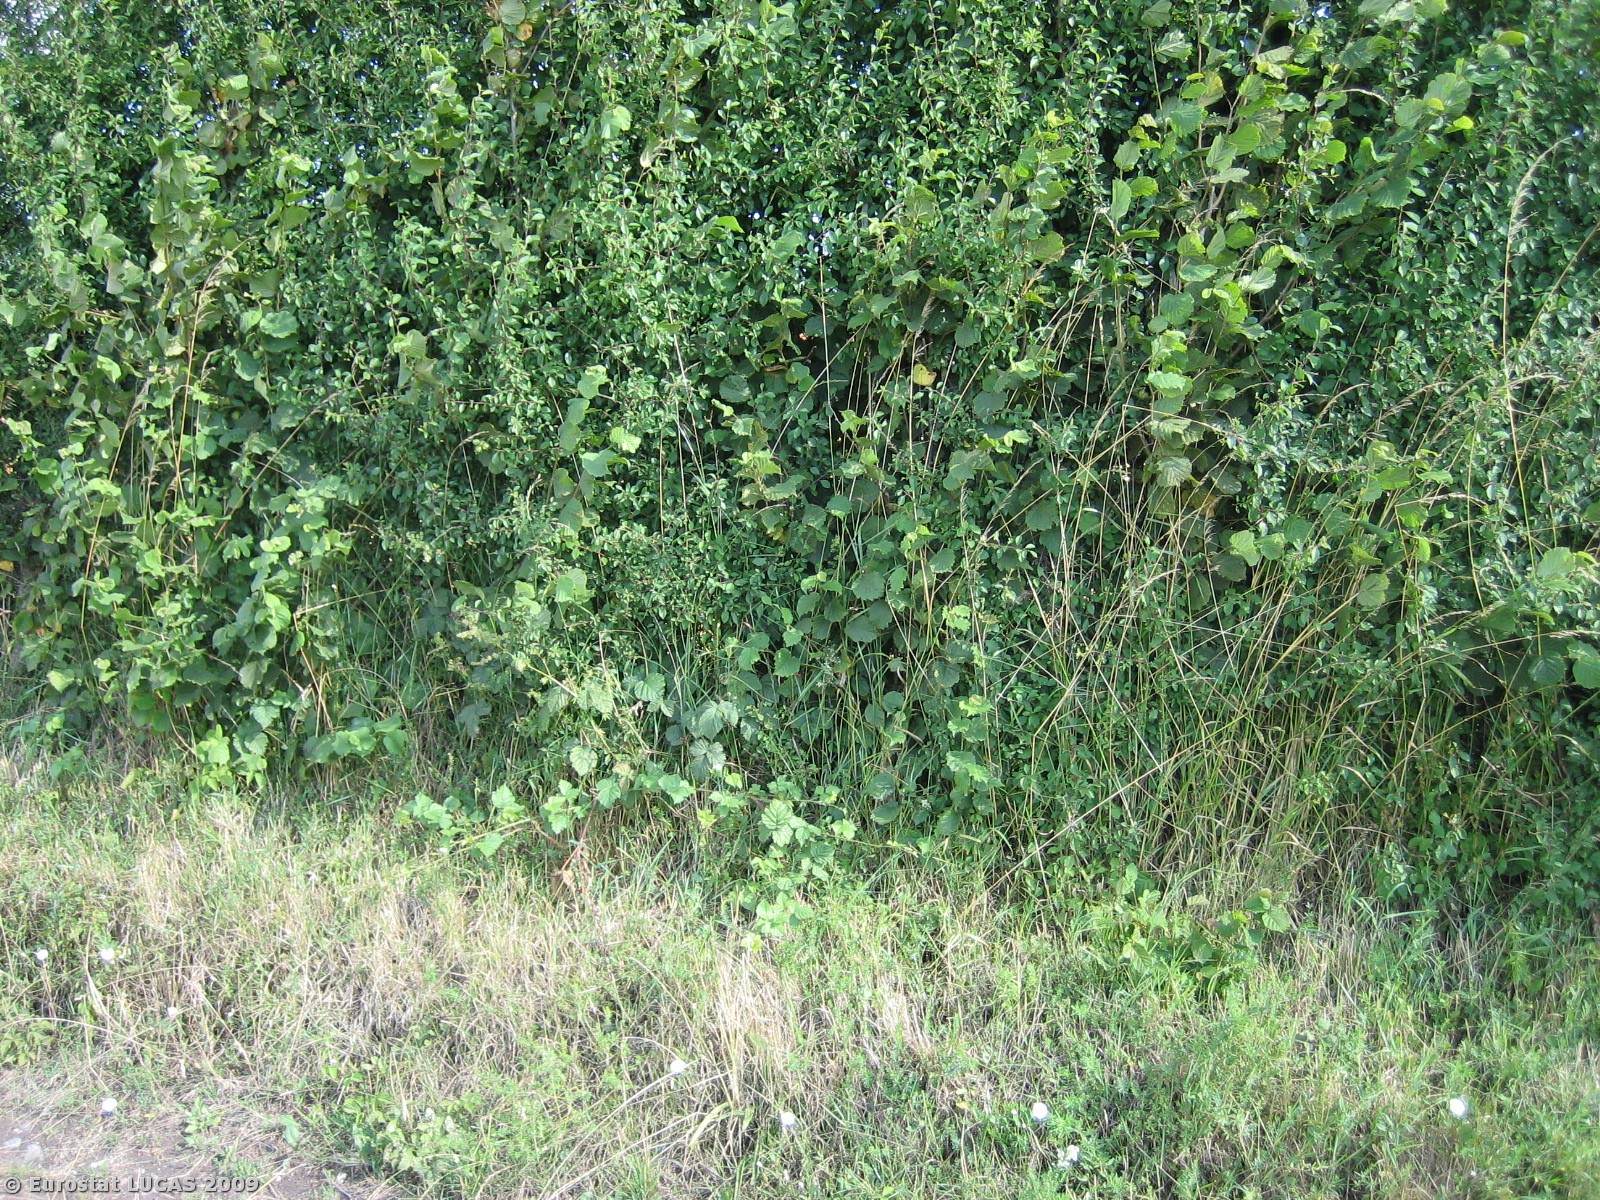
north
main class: Cropland
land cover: Temporary grasslands
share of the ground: > 75 %
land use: Agriculture (excluding fallow land and kitchen gardens)
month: July
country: DK
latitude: 55.3608
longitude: 9.8582
